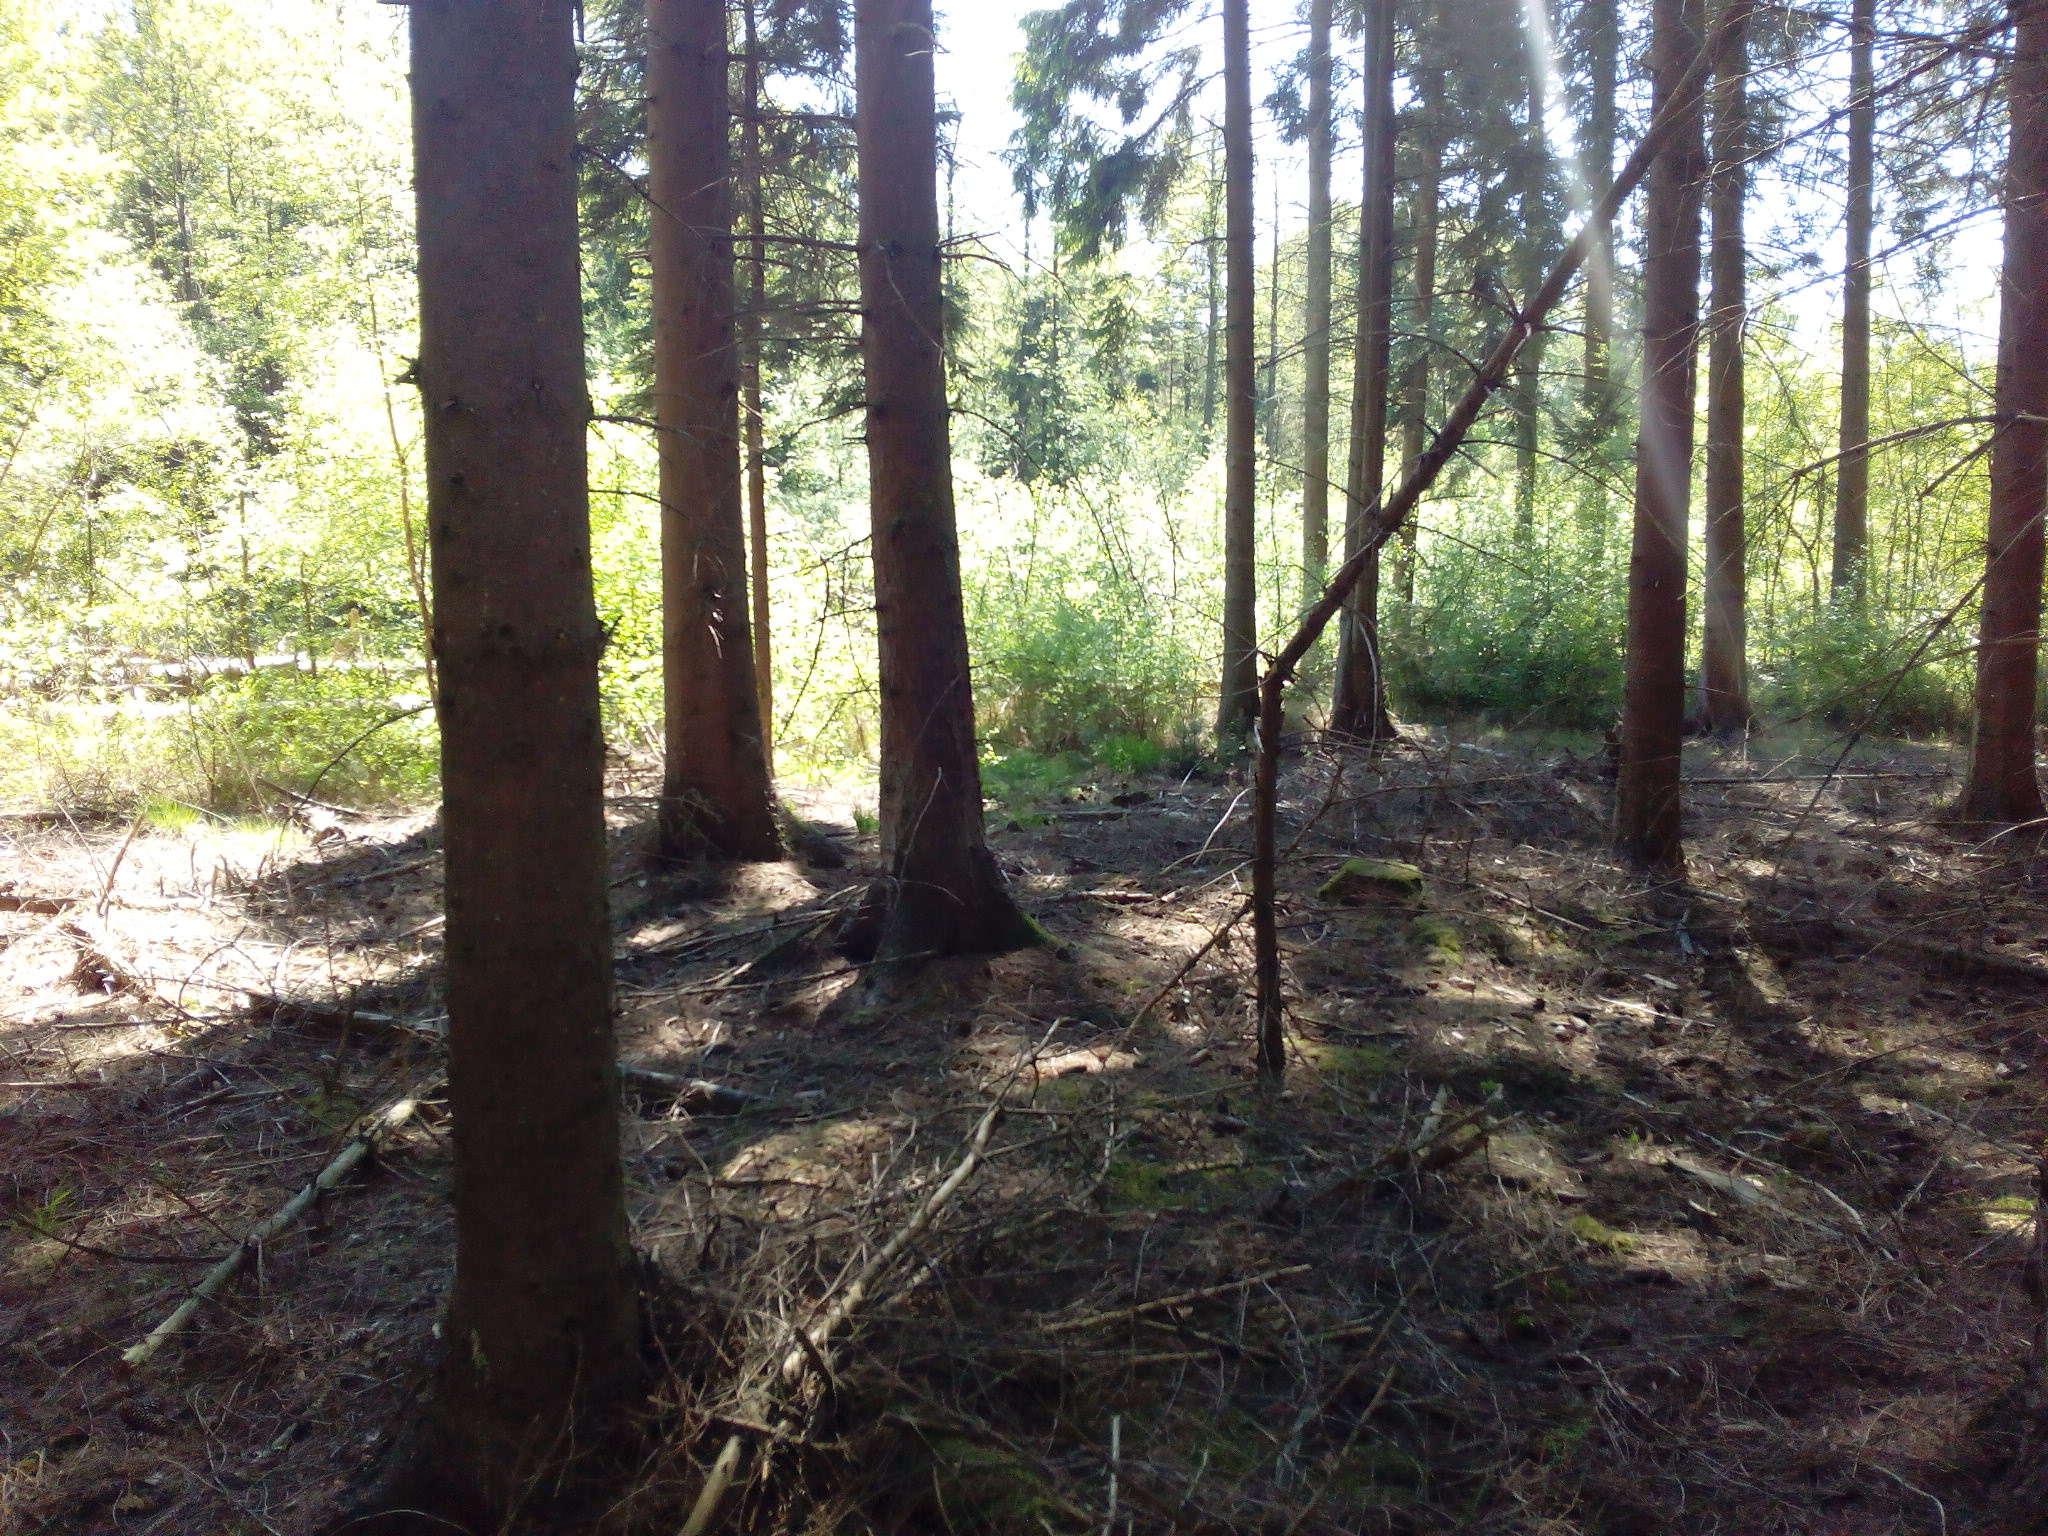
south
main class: Woodland
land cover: Spruce dominated mixed woodland
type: hemiboreal forest and nemoral coniferous forest and mixed broadleaved-coniferous forest
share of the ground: > 75 %
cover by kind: coniferous forest trees 60 %, broadleaved forest trees 30 %, herbaceous plants 10 %
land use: Forestry
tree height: > 5 m
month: May
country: DE
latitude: 52.5207
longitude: 9.6317
